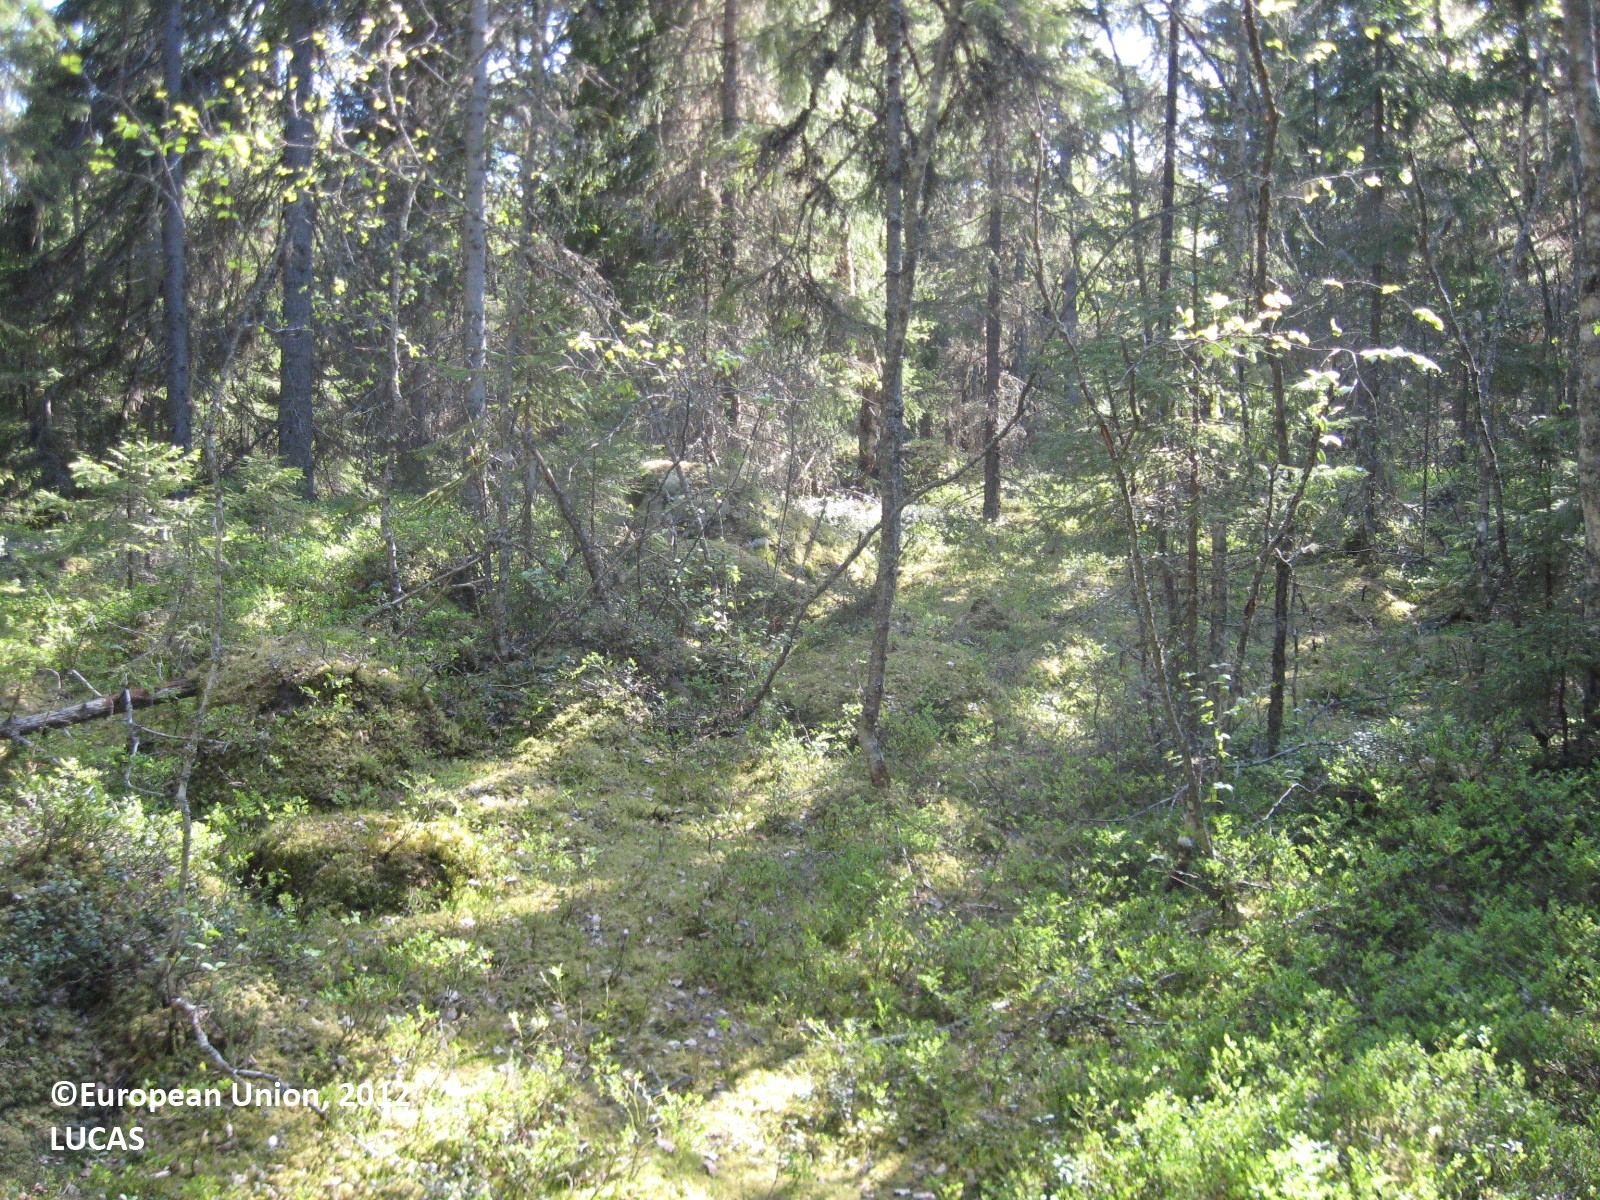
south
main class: Woodland
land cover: Spruce dominated coniferous woodland
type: boreal forest
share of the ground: > 75 %
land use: Forestry
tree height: > 5 m
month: June
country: FI
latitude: 63.2546
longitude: 21.4093
